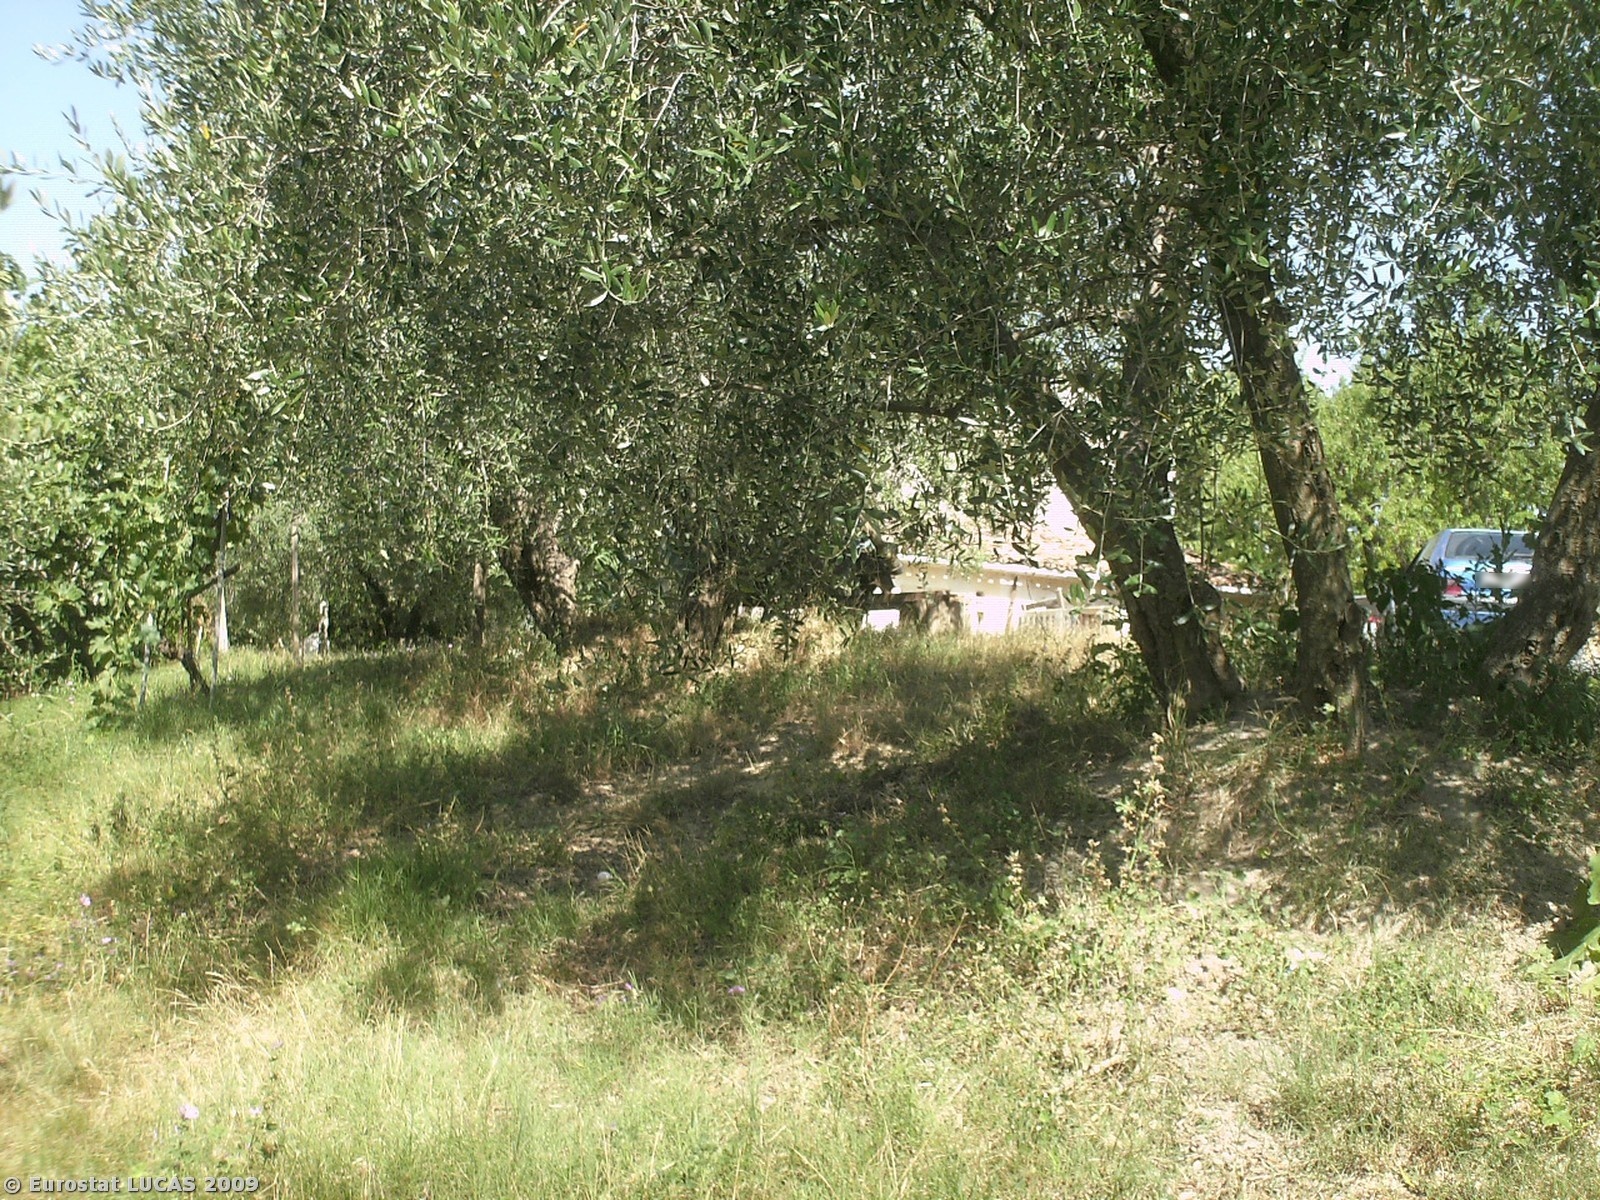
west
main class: Cropland
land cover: Olive groves
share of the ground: 25 - 50 %
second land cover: Grassland with sparse tree/shrub cover
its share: > 75 %
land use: Agriculture (excluding fallow land and kitchen gardens)
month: July
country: IT
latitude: 43.8777
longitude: 12.8682
